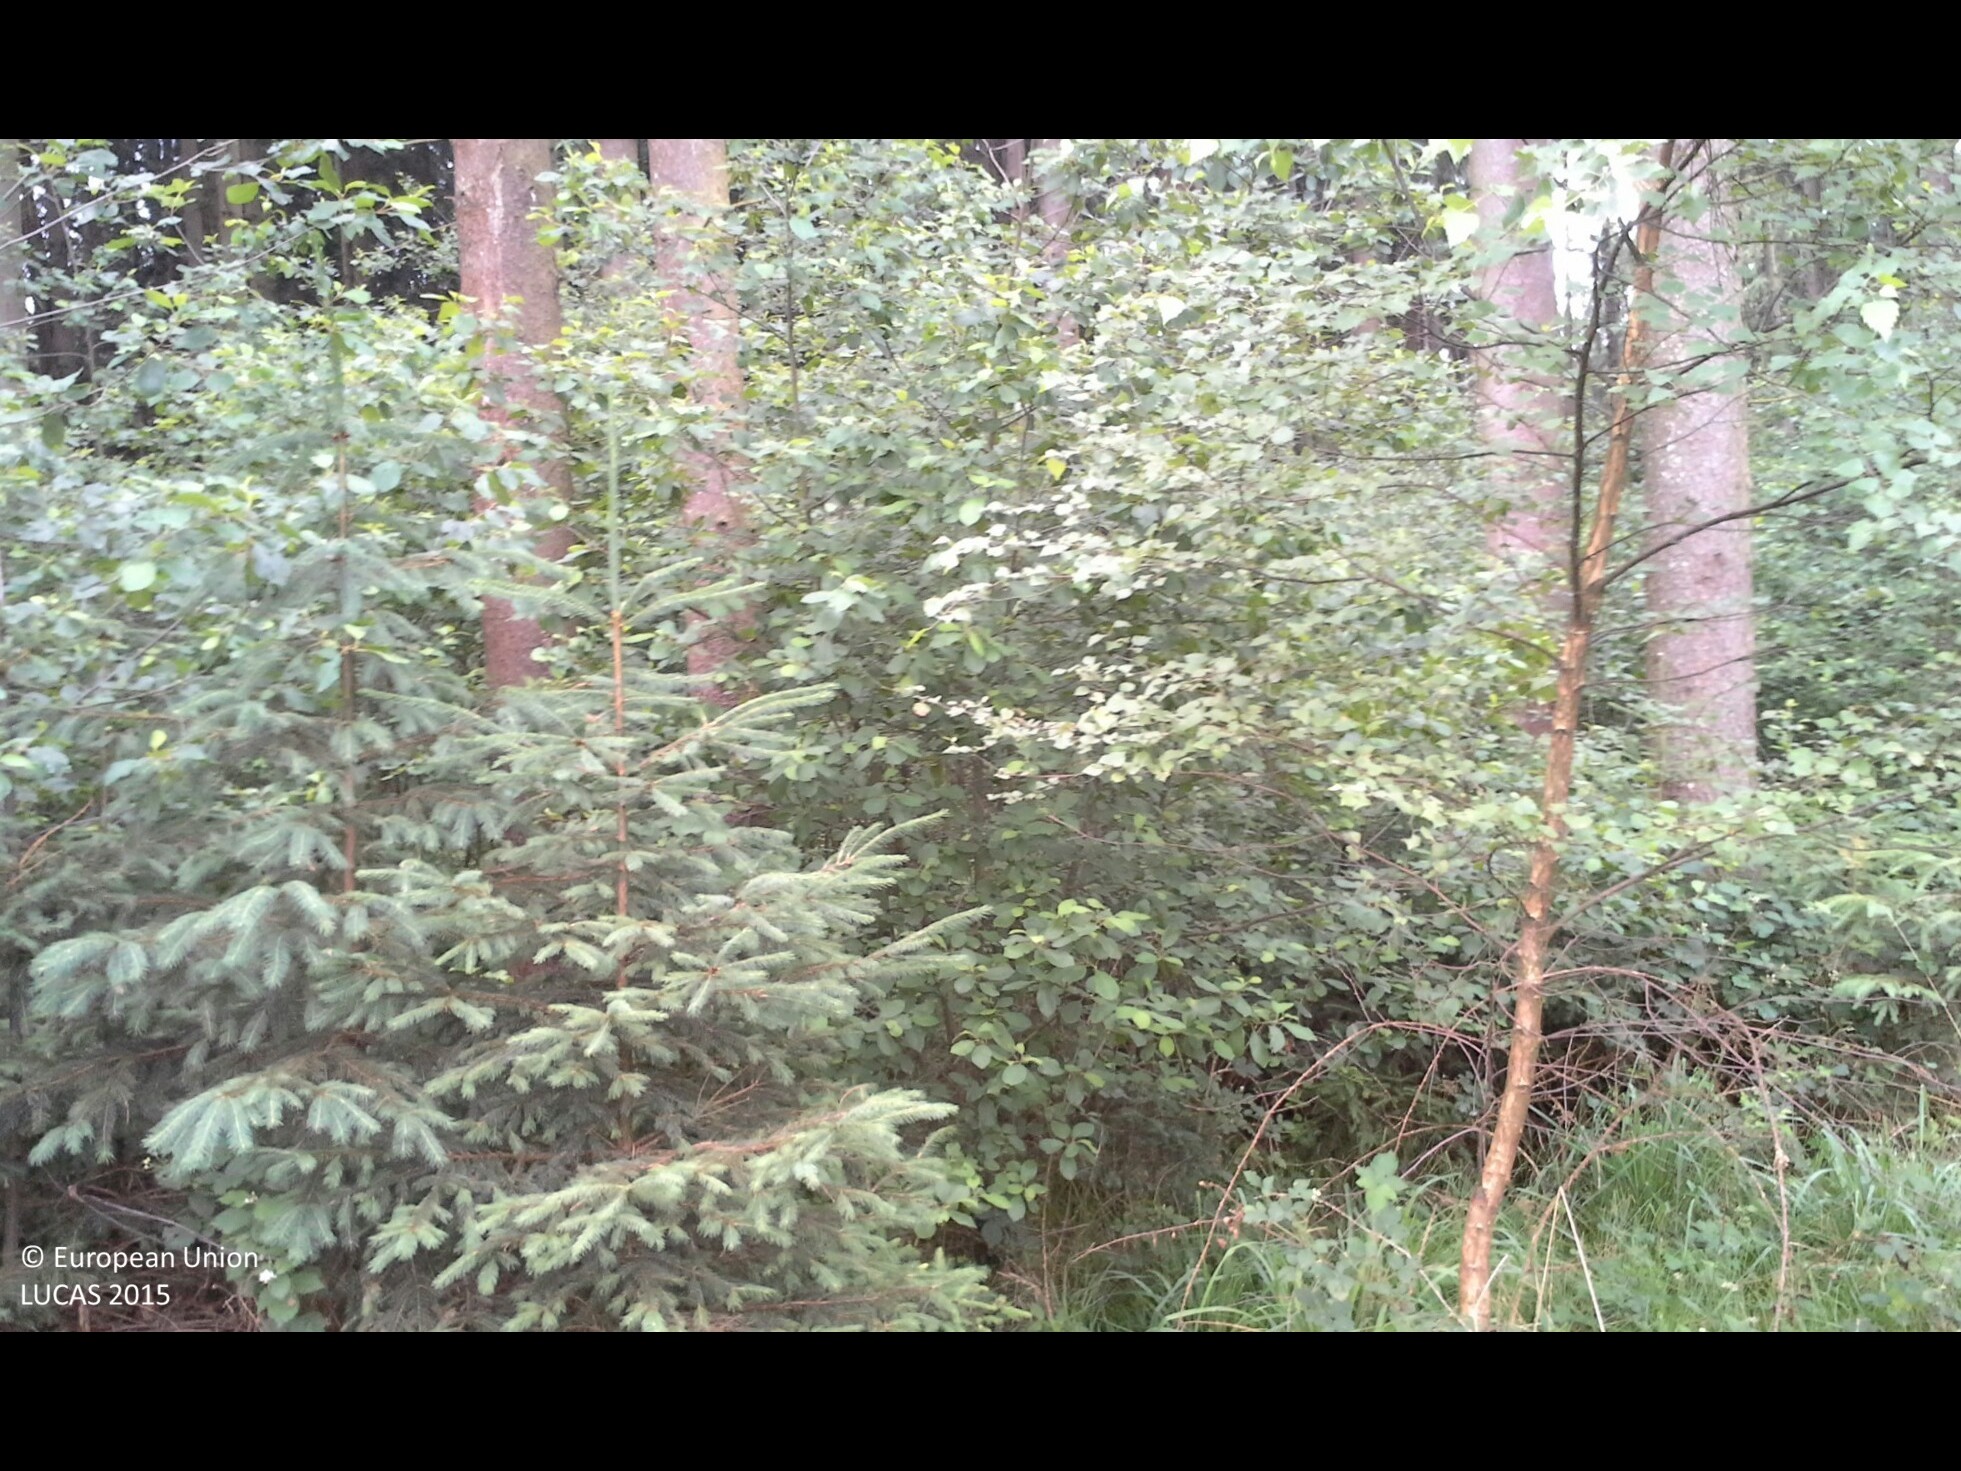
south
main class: Woodland
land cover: Spruce dominated mixed woodland
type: hemiboreal forest and nemoral coniferous forest and mixed broadleaved-coniferous forest
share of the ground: > 75 %
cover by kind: coniferous forest trees 60 %, broadleaved forest trees 25 %, herbaceous plants 10 %, shrubs 5 %
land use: Forestry
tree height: > 5 m
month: June
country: AT
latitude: 48.0924
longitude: 14.5787
